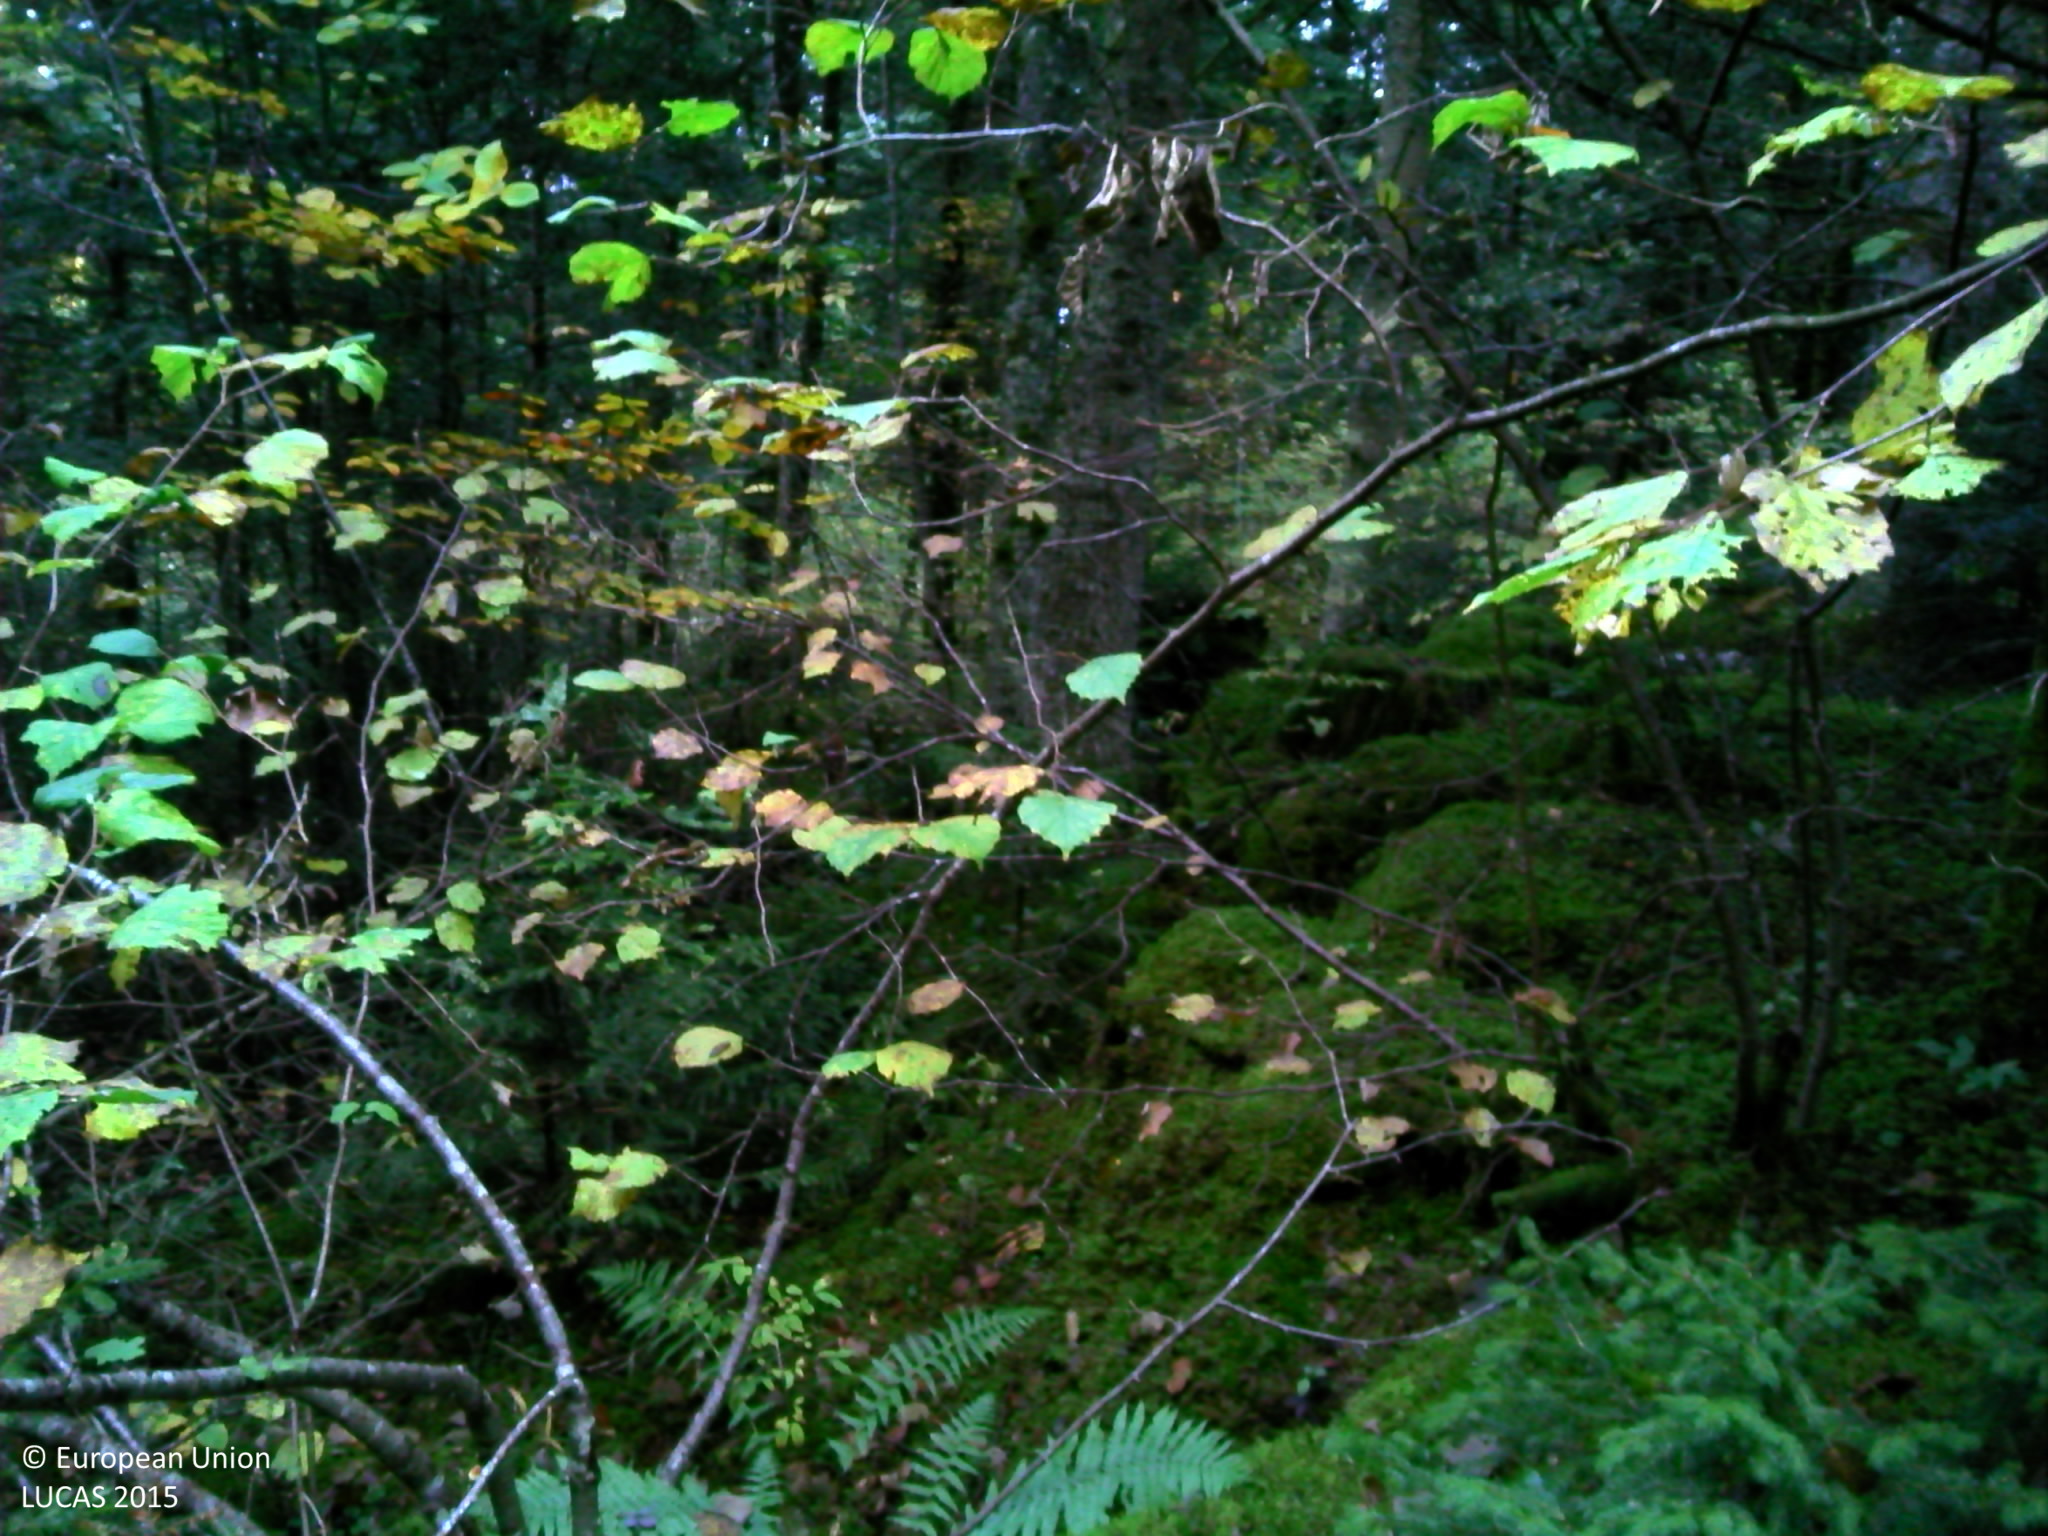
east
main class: Woodland
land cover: Spruce dominated mixed woodland
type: hemiboreal forest and nemoral coniferous forest and mixed broadleaved-coniferous forest
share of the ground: > 75 %
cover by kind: coniferous forest trees 40 %, broadleaved forest trees 40 %, shrubs 20 %
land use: Forestry
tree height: > 5 m
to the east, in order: Spruce dominated mixed woodland; Tracks; Spruce dominated mixed woodland
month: October
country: FR
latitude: 46.7927
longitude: 6.3213
